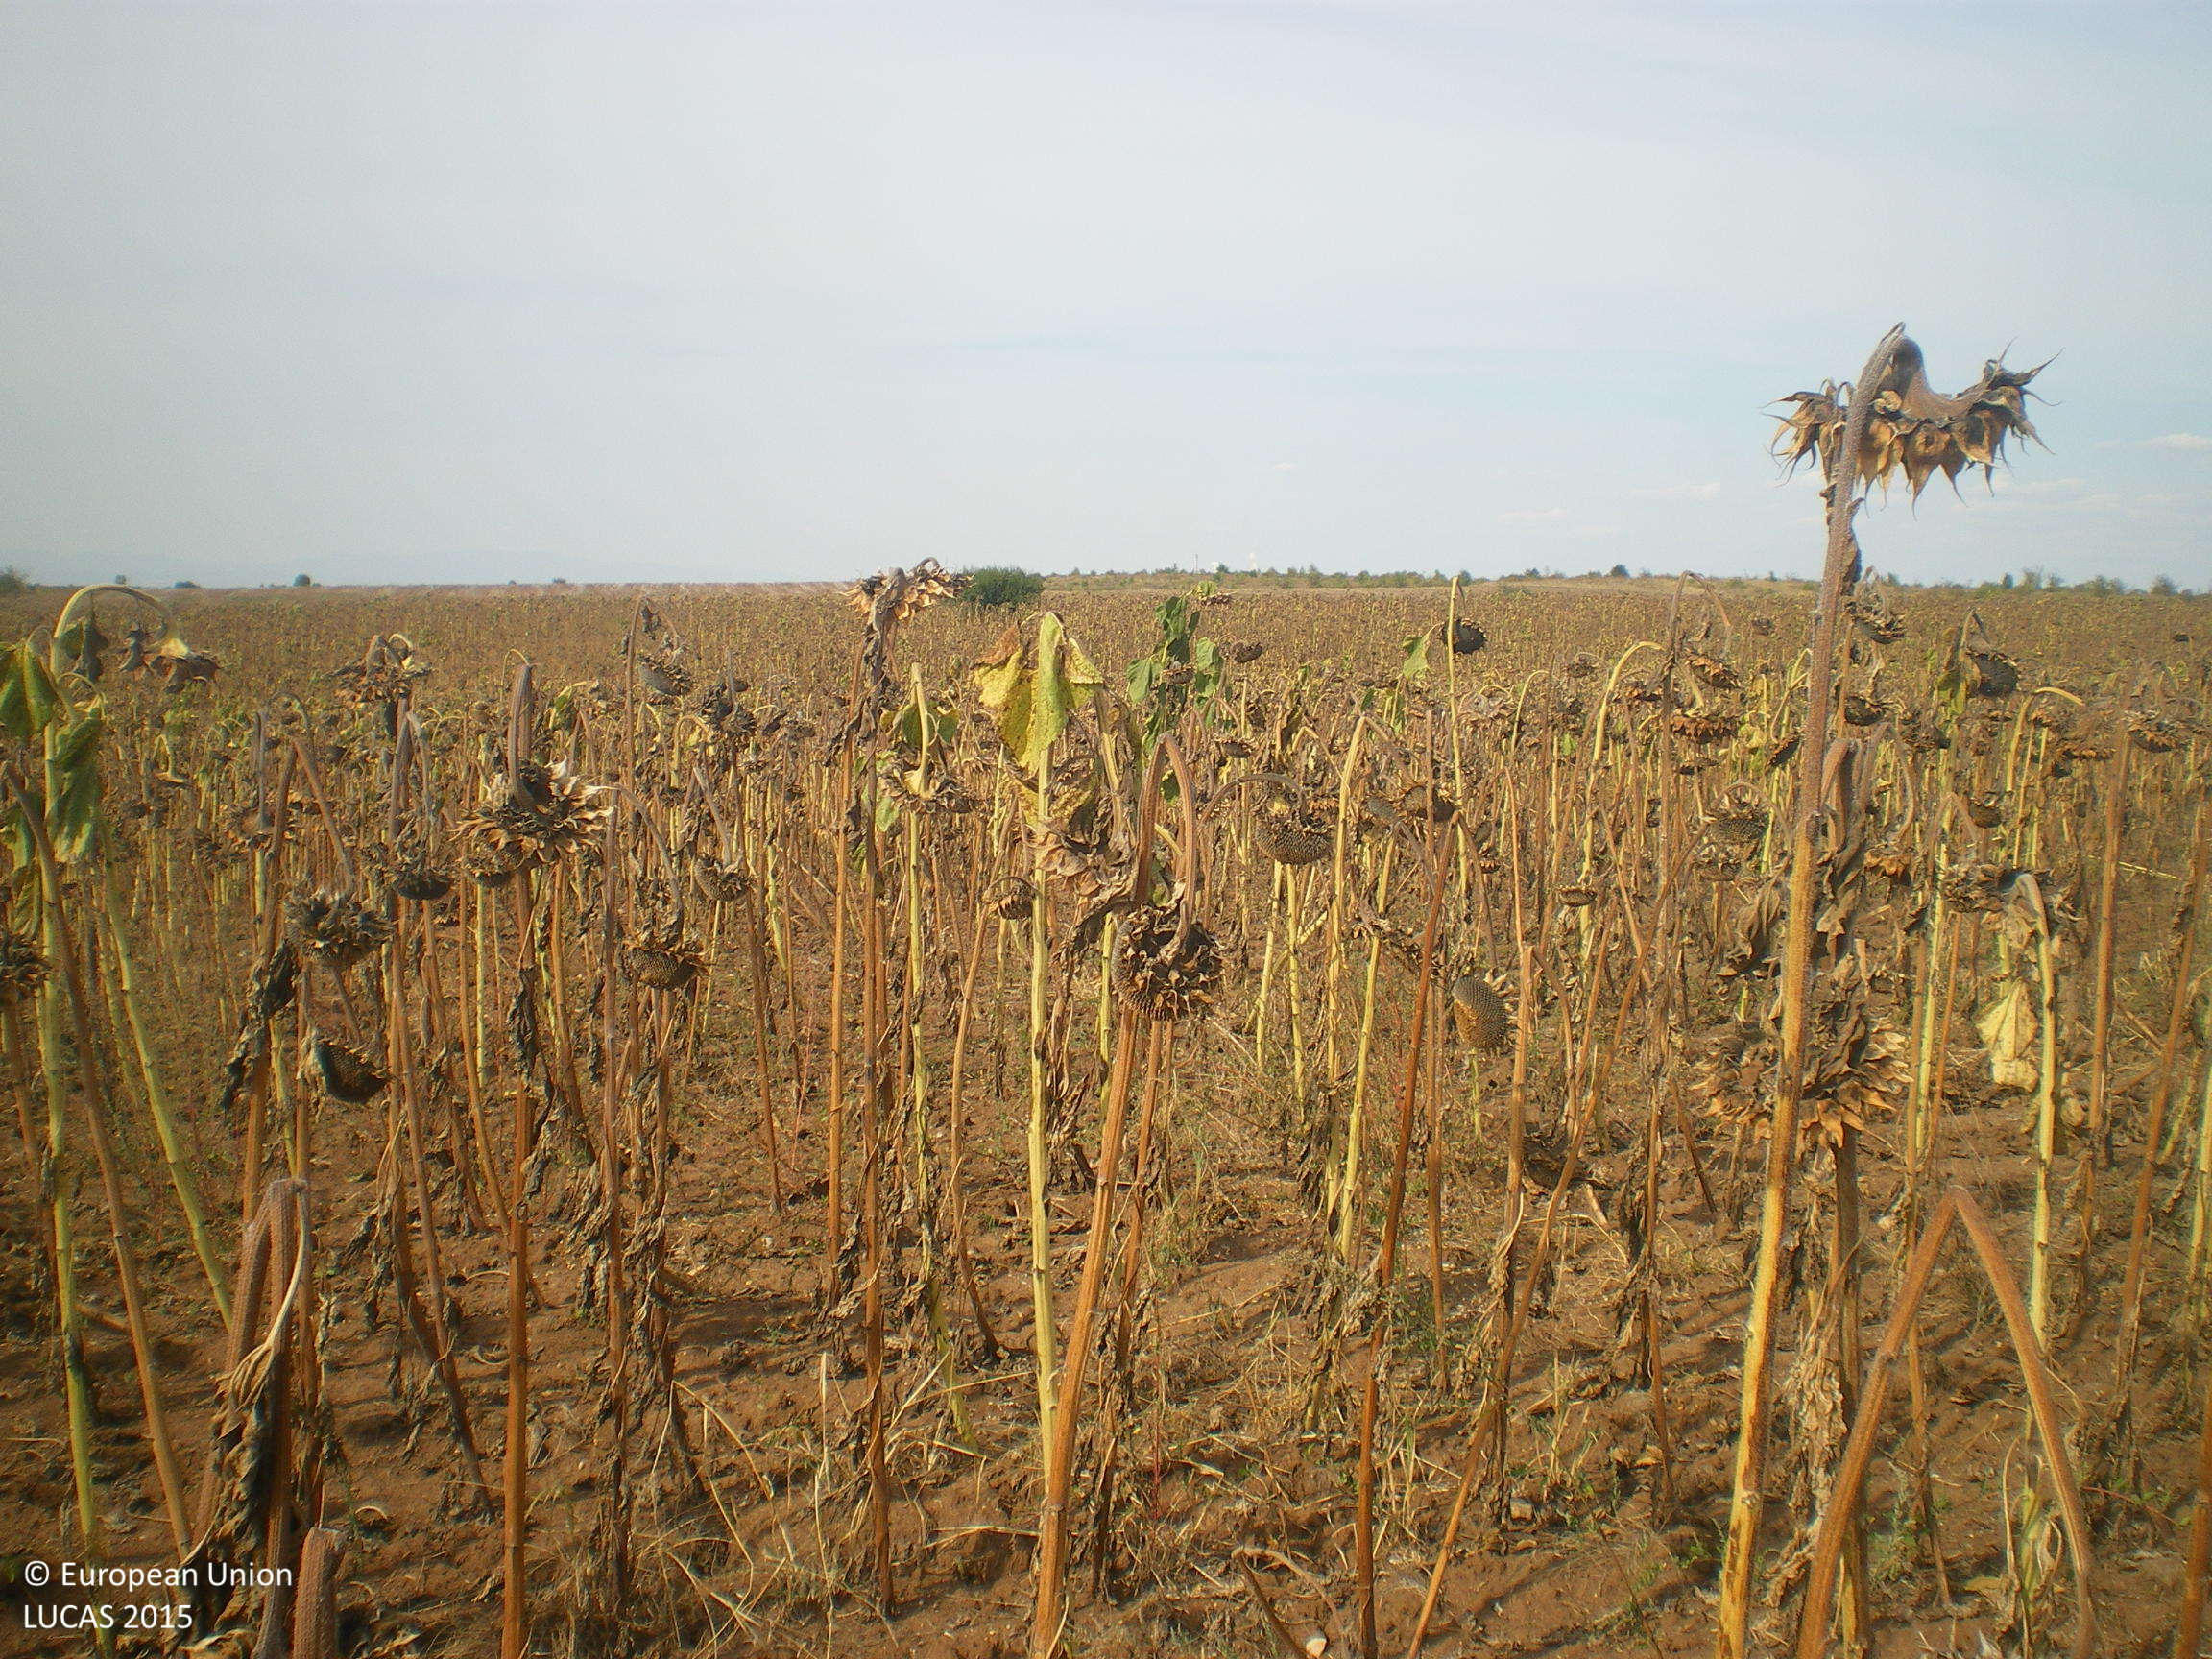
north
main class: Cropland
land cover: Sunflower
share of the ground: > 75 %
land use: Agriculture (excluding fallow land and kitchen gardens)
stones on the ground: < 10 %
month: September
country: BG
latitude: 42.1622
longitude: 26.1164
